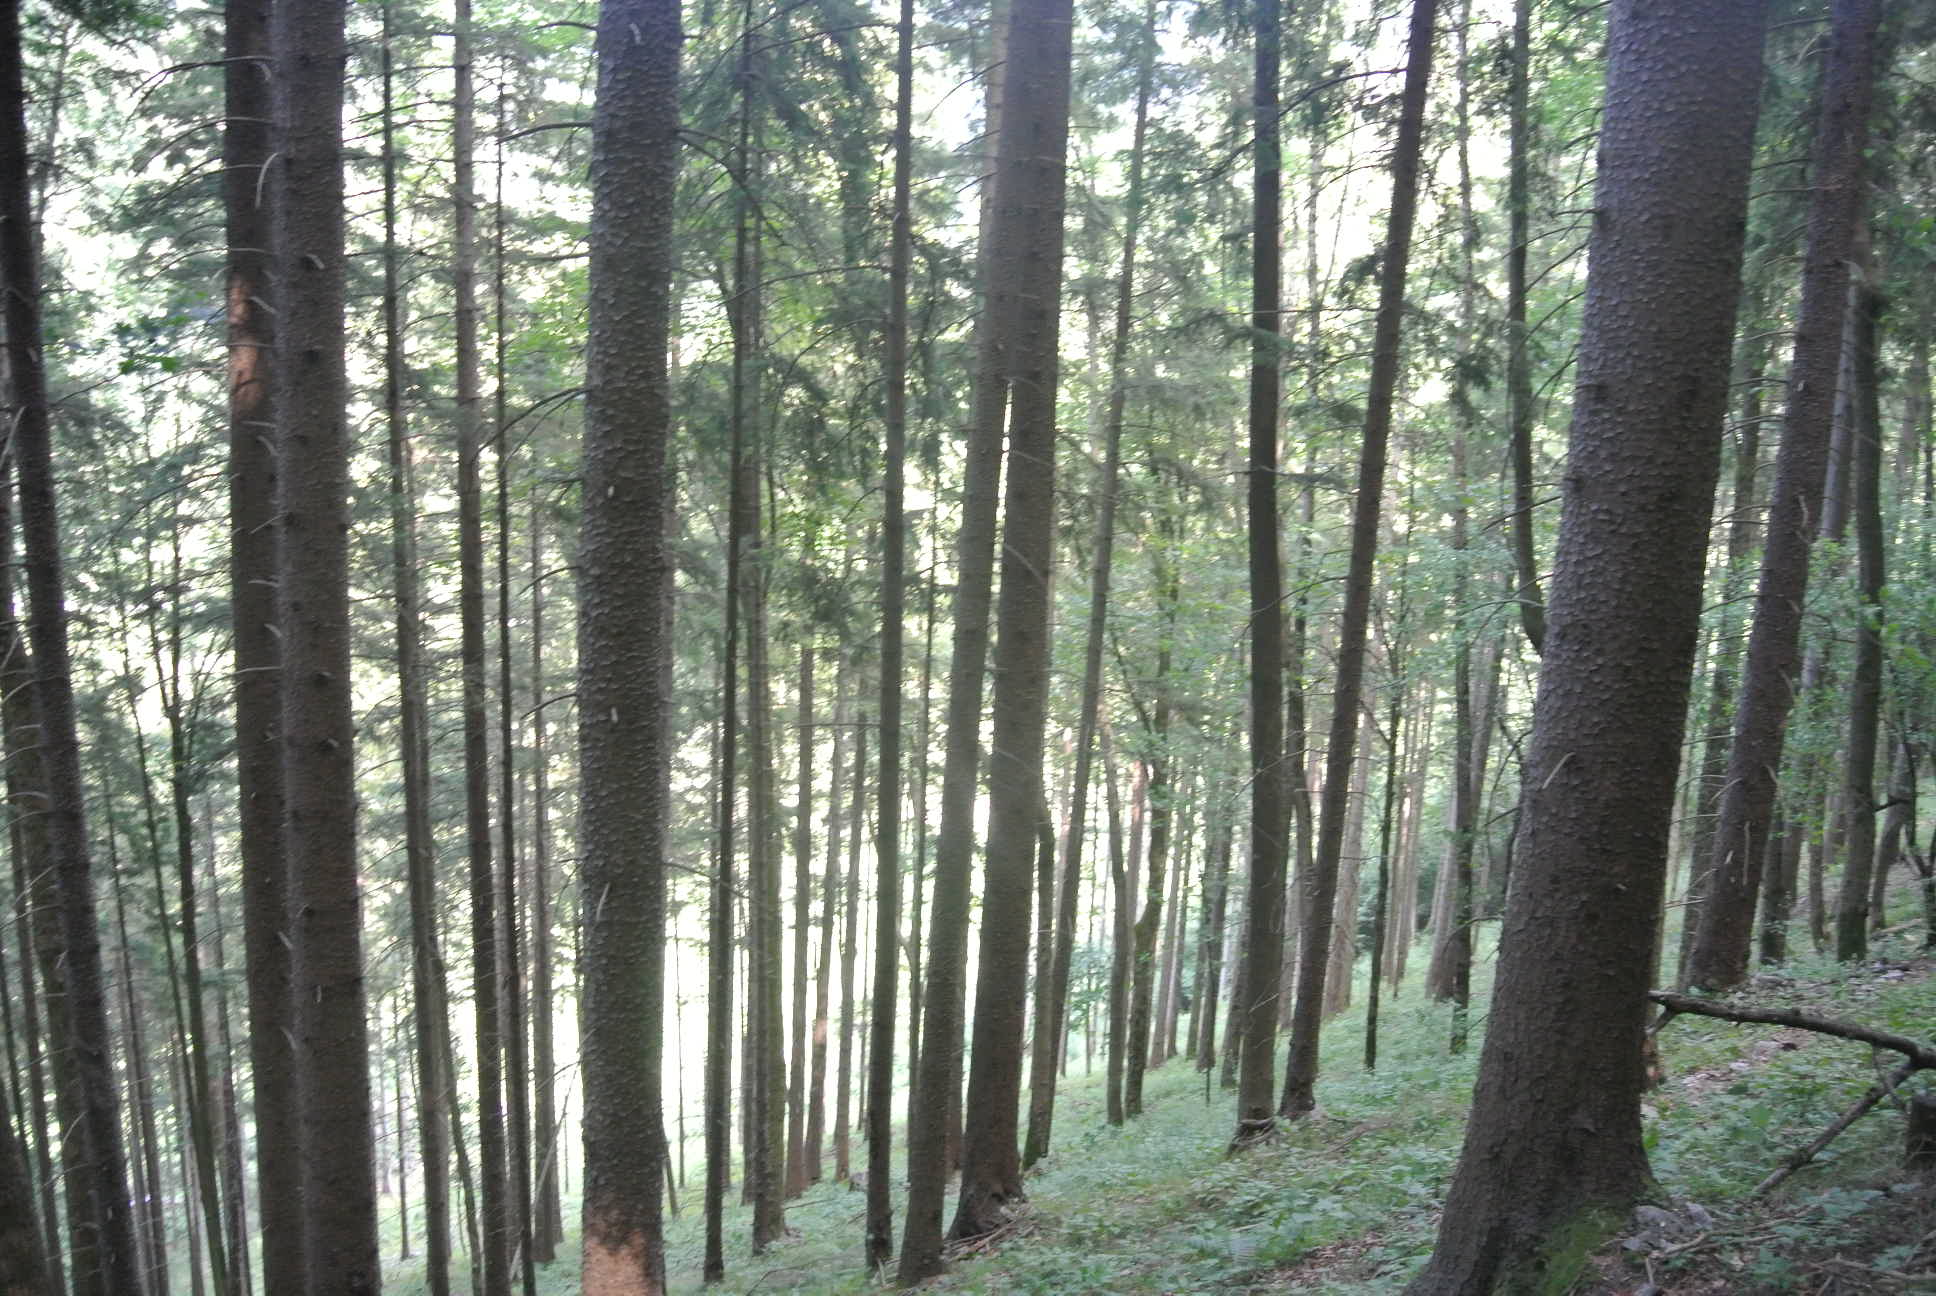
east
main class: Woodland
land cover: Spruce dominated mixed woodland
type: alpine coniferous forest
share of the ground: > 75 %
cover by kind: coniferous forest trees 75 %, broadleaved forest trees 25 %
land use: Forestry
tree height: > 5 m
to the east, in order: Spruce dominated mixed woodland; Spontaneously vegetated surfaces; Shrubland without tree cover; Grassland without tree/shrub cover; Railways; Electric lines; Shrubland without tree cover; Grassland without tree/shrub cover; Paved roads, cycling and walking lanes
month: July
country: AT
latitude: 47.9557
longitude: 15.5862
